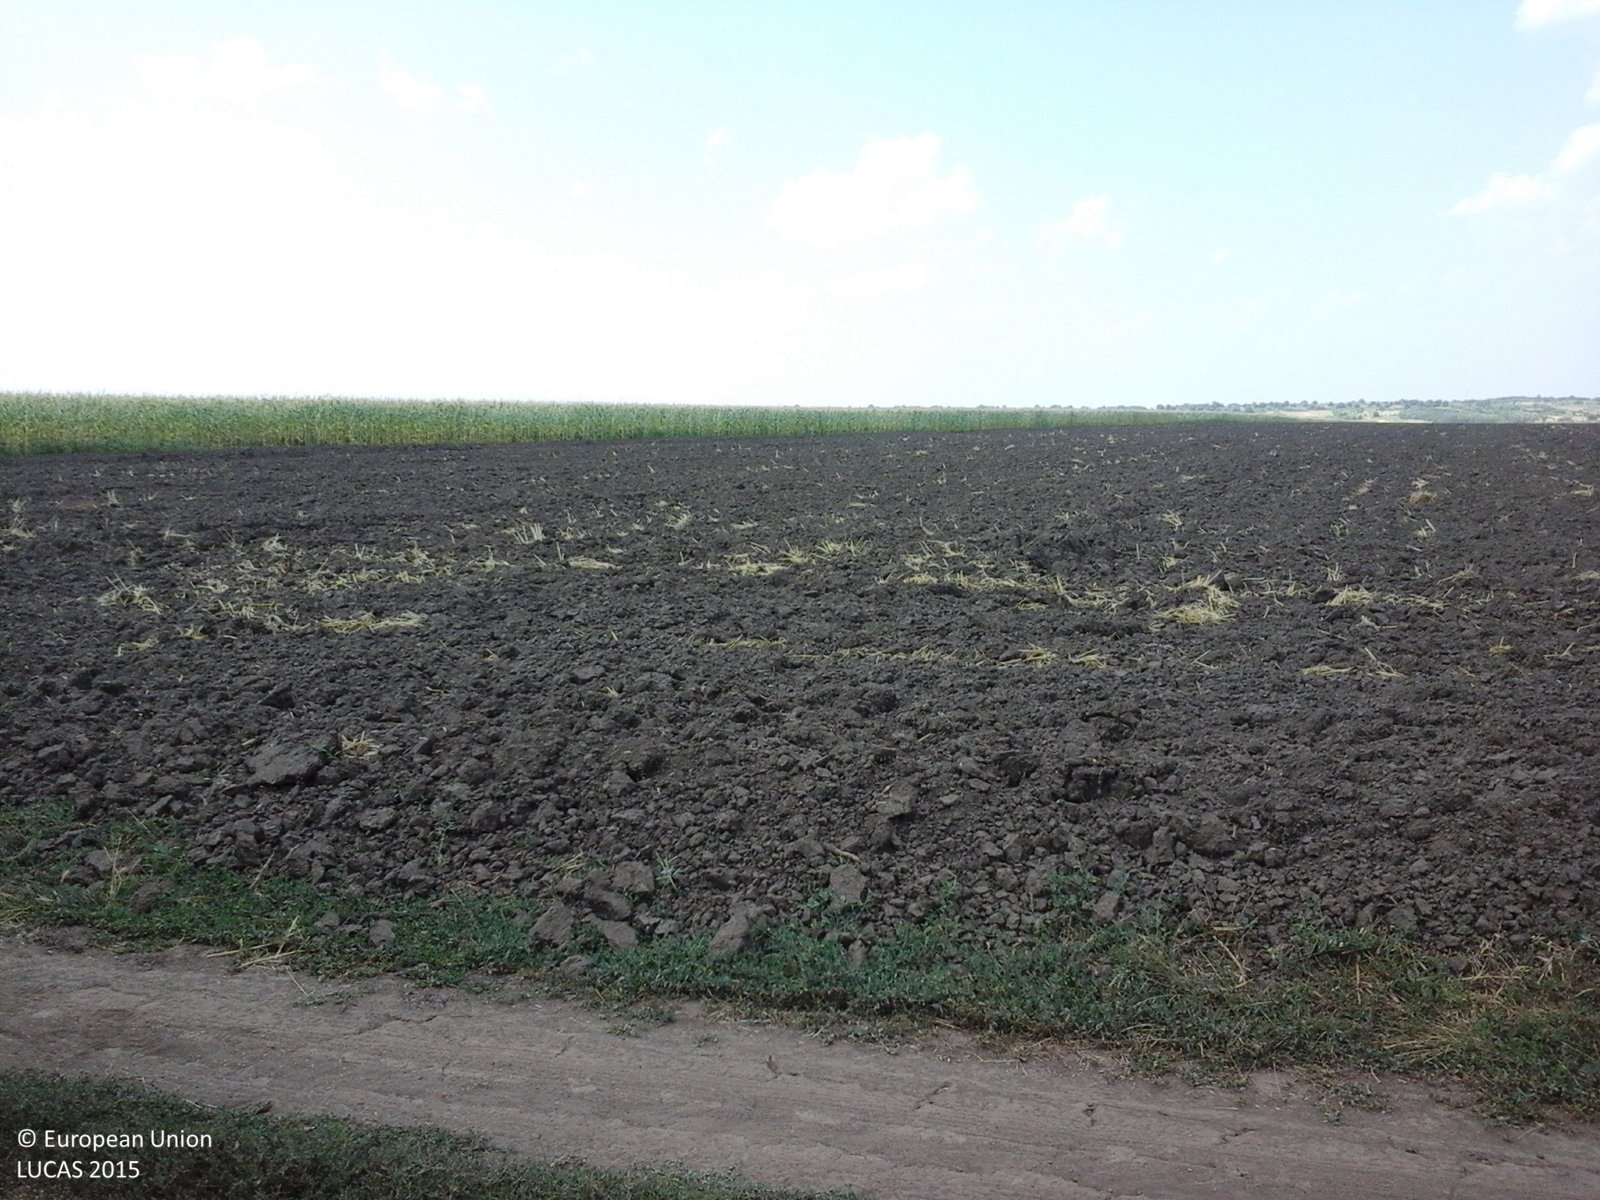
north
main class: Cropland
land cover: Maize
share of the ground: > 75 %
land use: Agriculture (excluding fallow land and kitchen gardens)
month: July
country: RO
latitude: 45.8689
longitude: 27.6157
